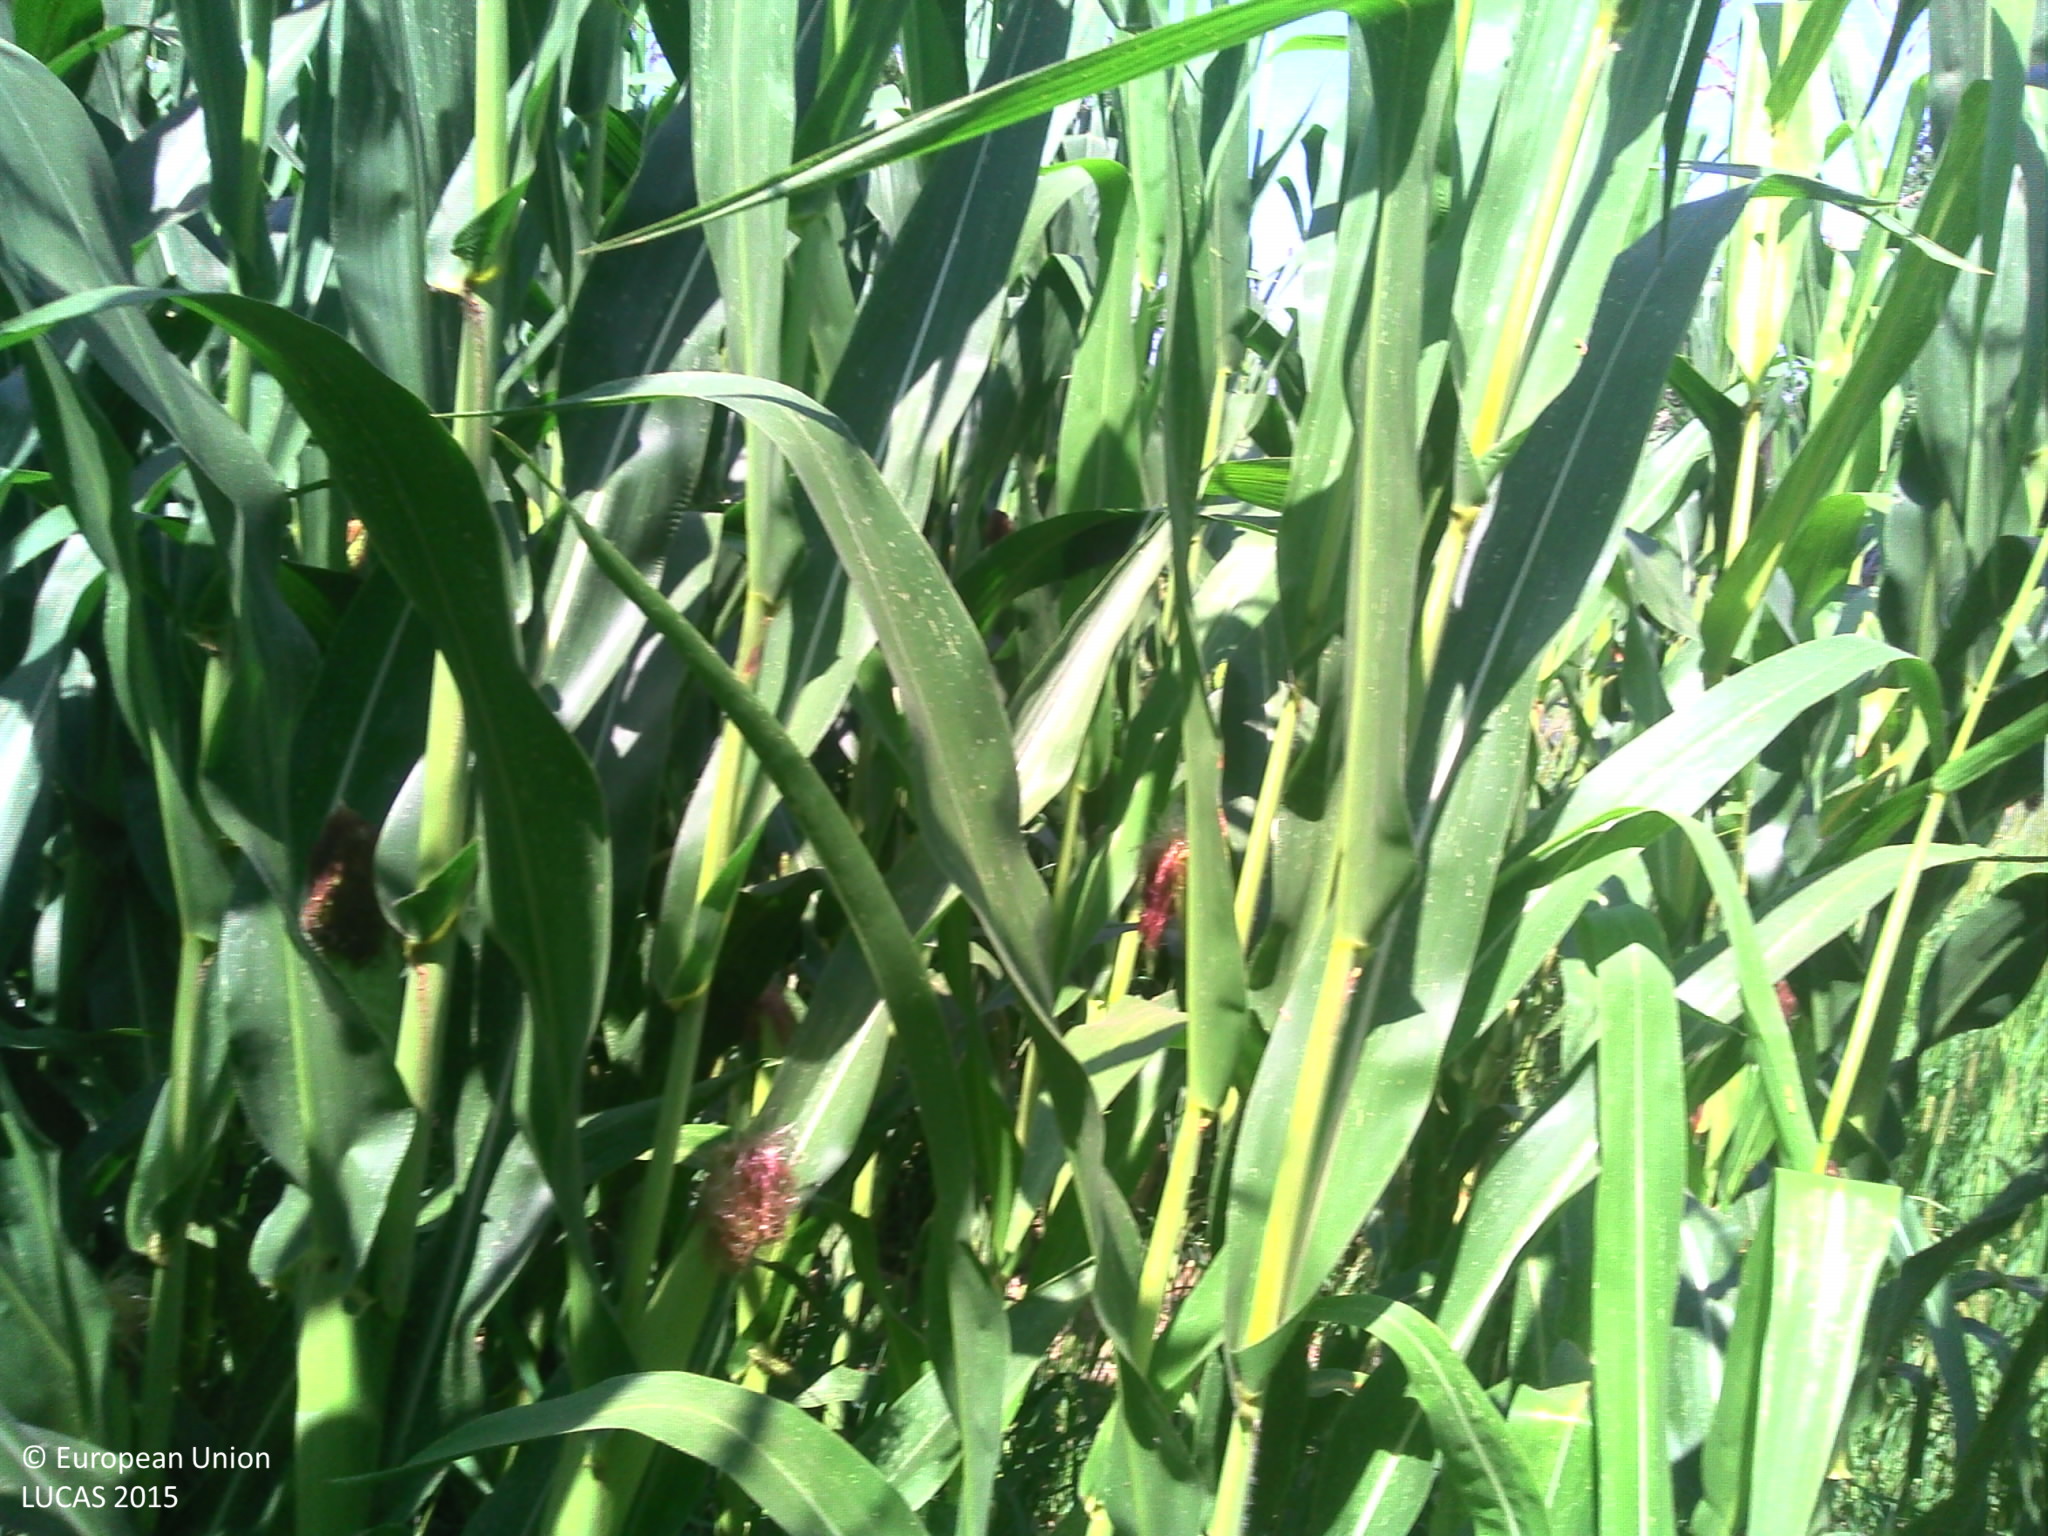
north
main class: Cropland
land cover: Maize
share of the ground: > 75 %
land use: Agriculture (excluding fallow land and kitchen gardens)
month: August
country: FR
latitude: 44.0350
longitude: 1.2521
